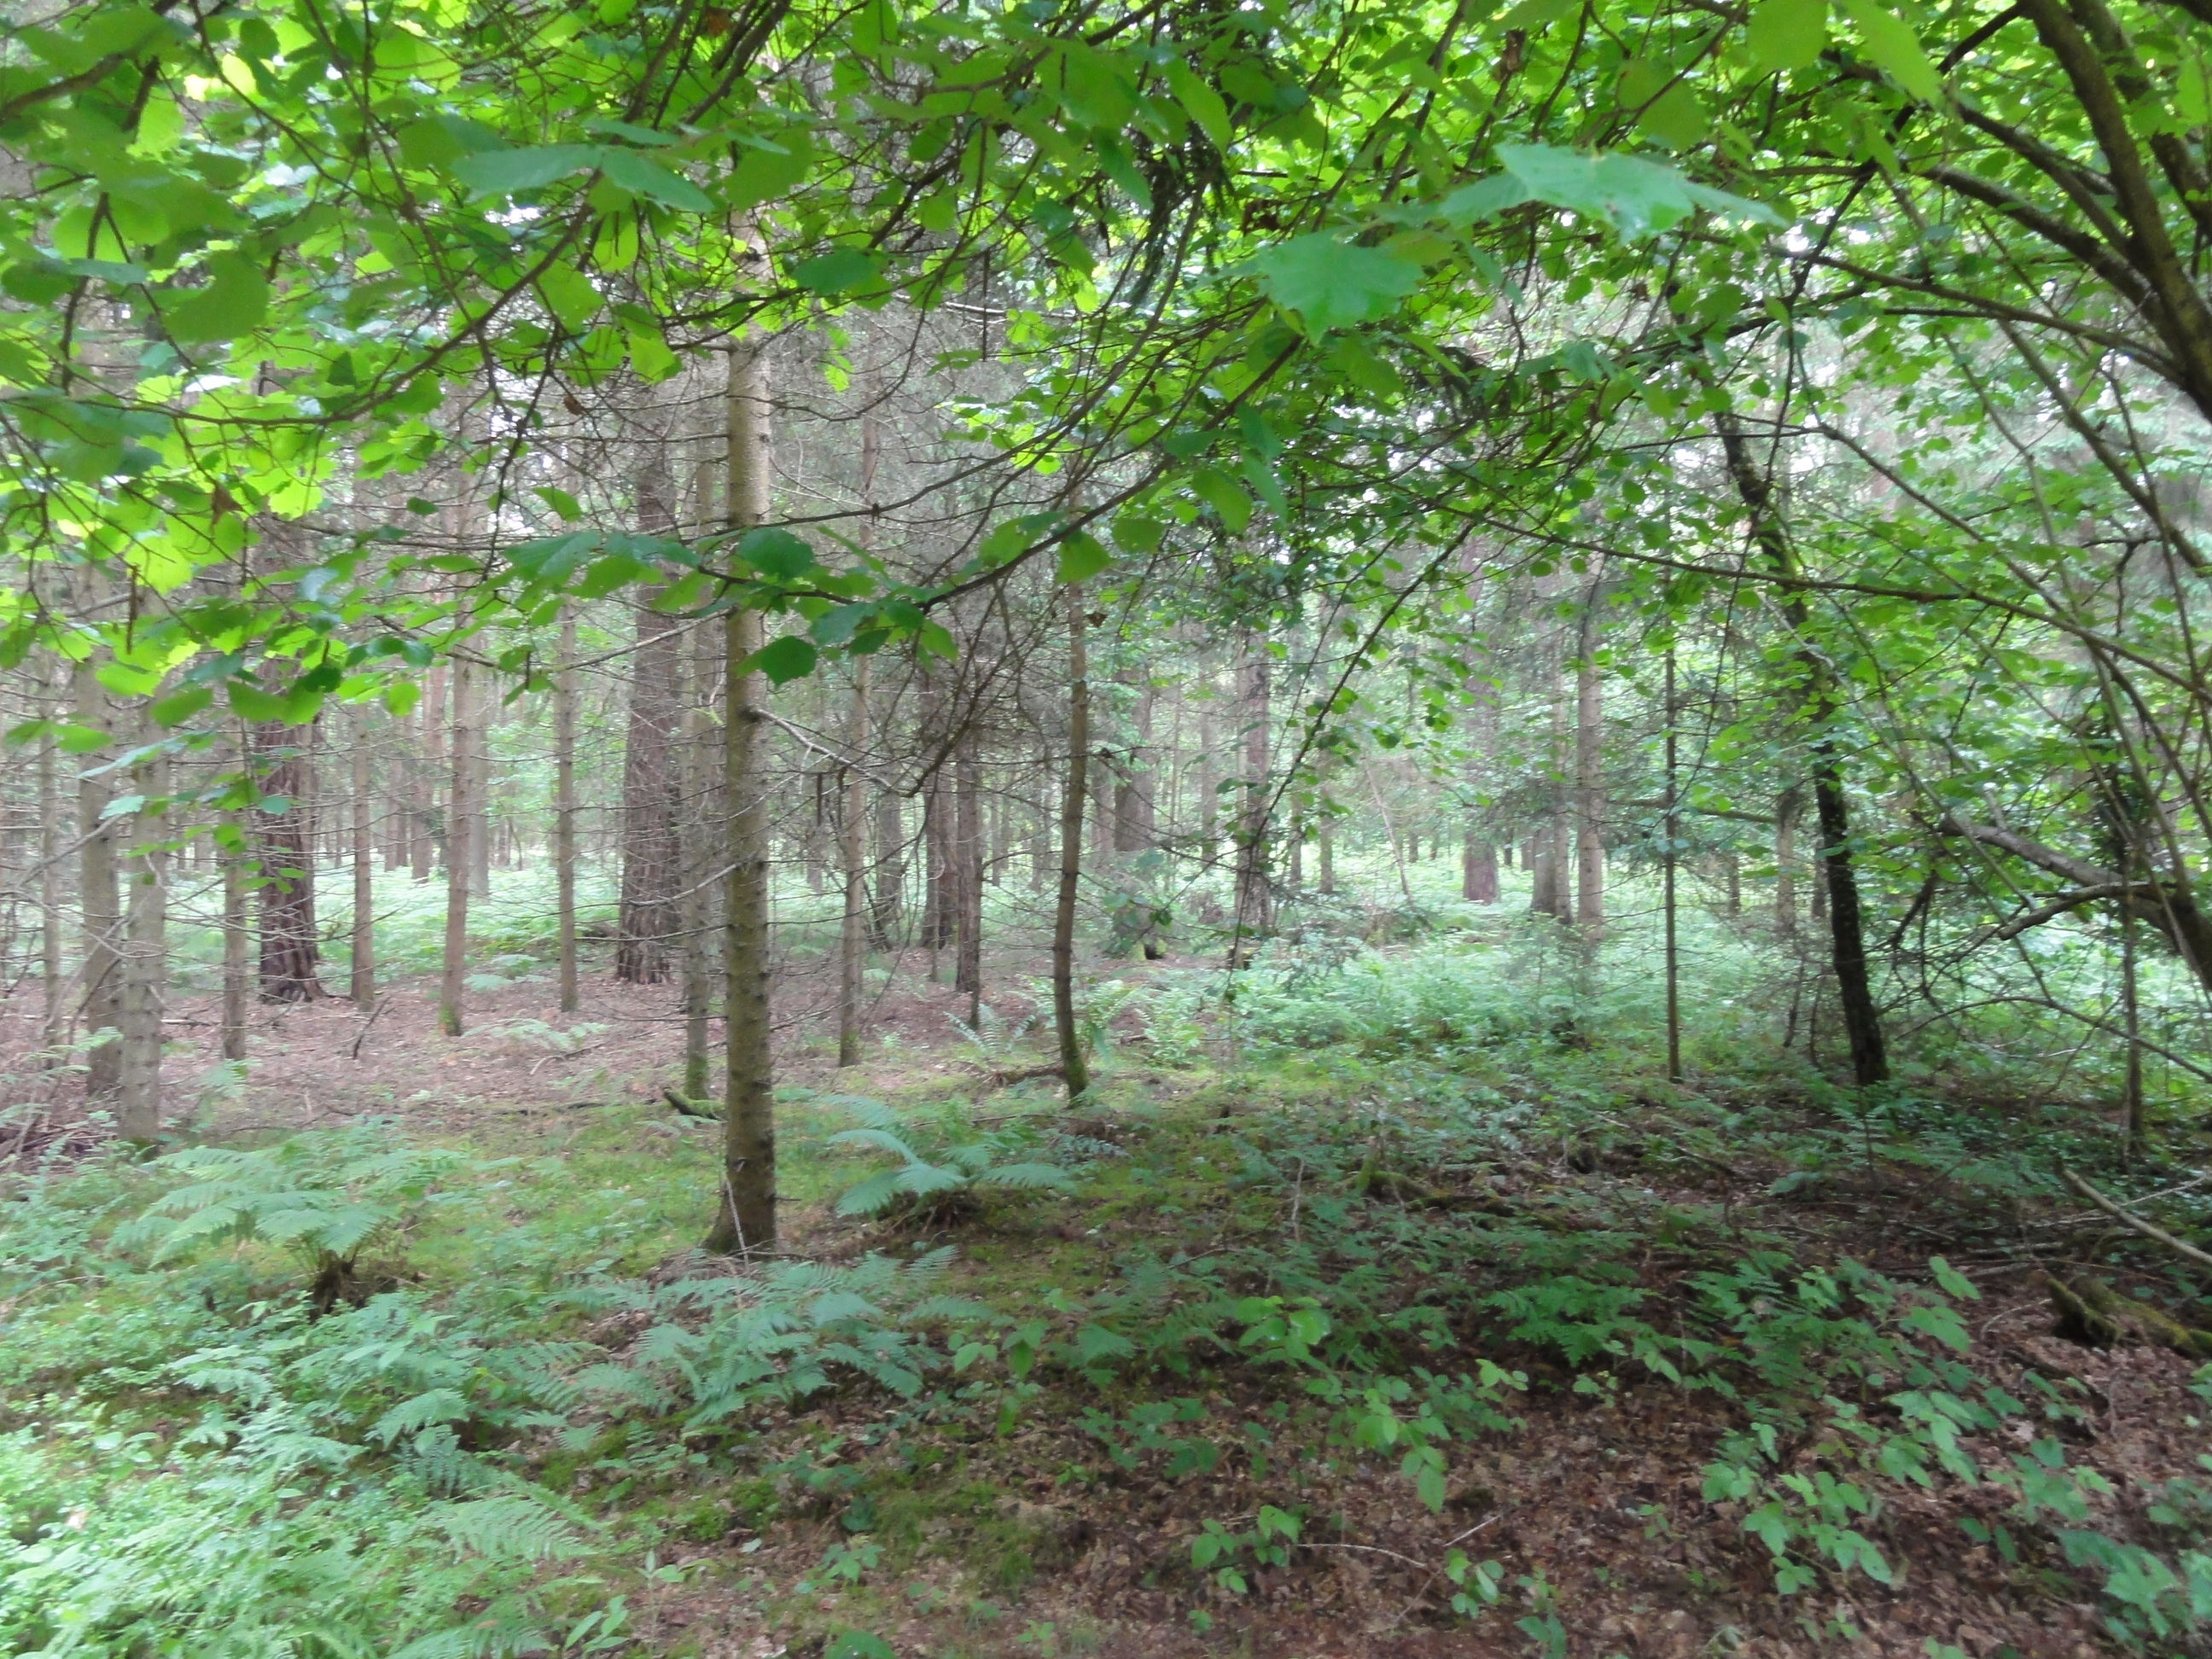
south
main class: Woodland
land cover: Other mixed woodland
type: hemiboreal forest and nemoral coniferous forest and mixed broadleaved-coniferous forest
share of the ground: > 75 %
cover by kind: coniferous forest trees 70 %, broadleaved forest trees 25 %, herbaceous plants 5 %
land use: Forestry
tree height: > 5 m
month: May
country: SI
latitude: 46.4871
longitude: 15.7180
